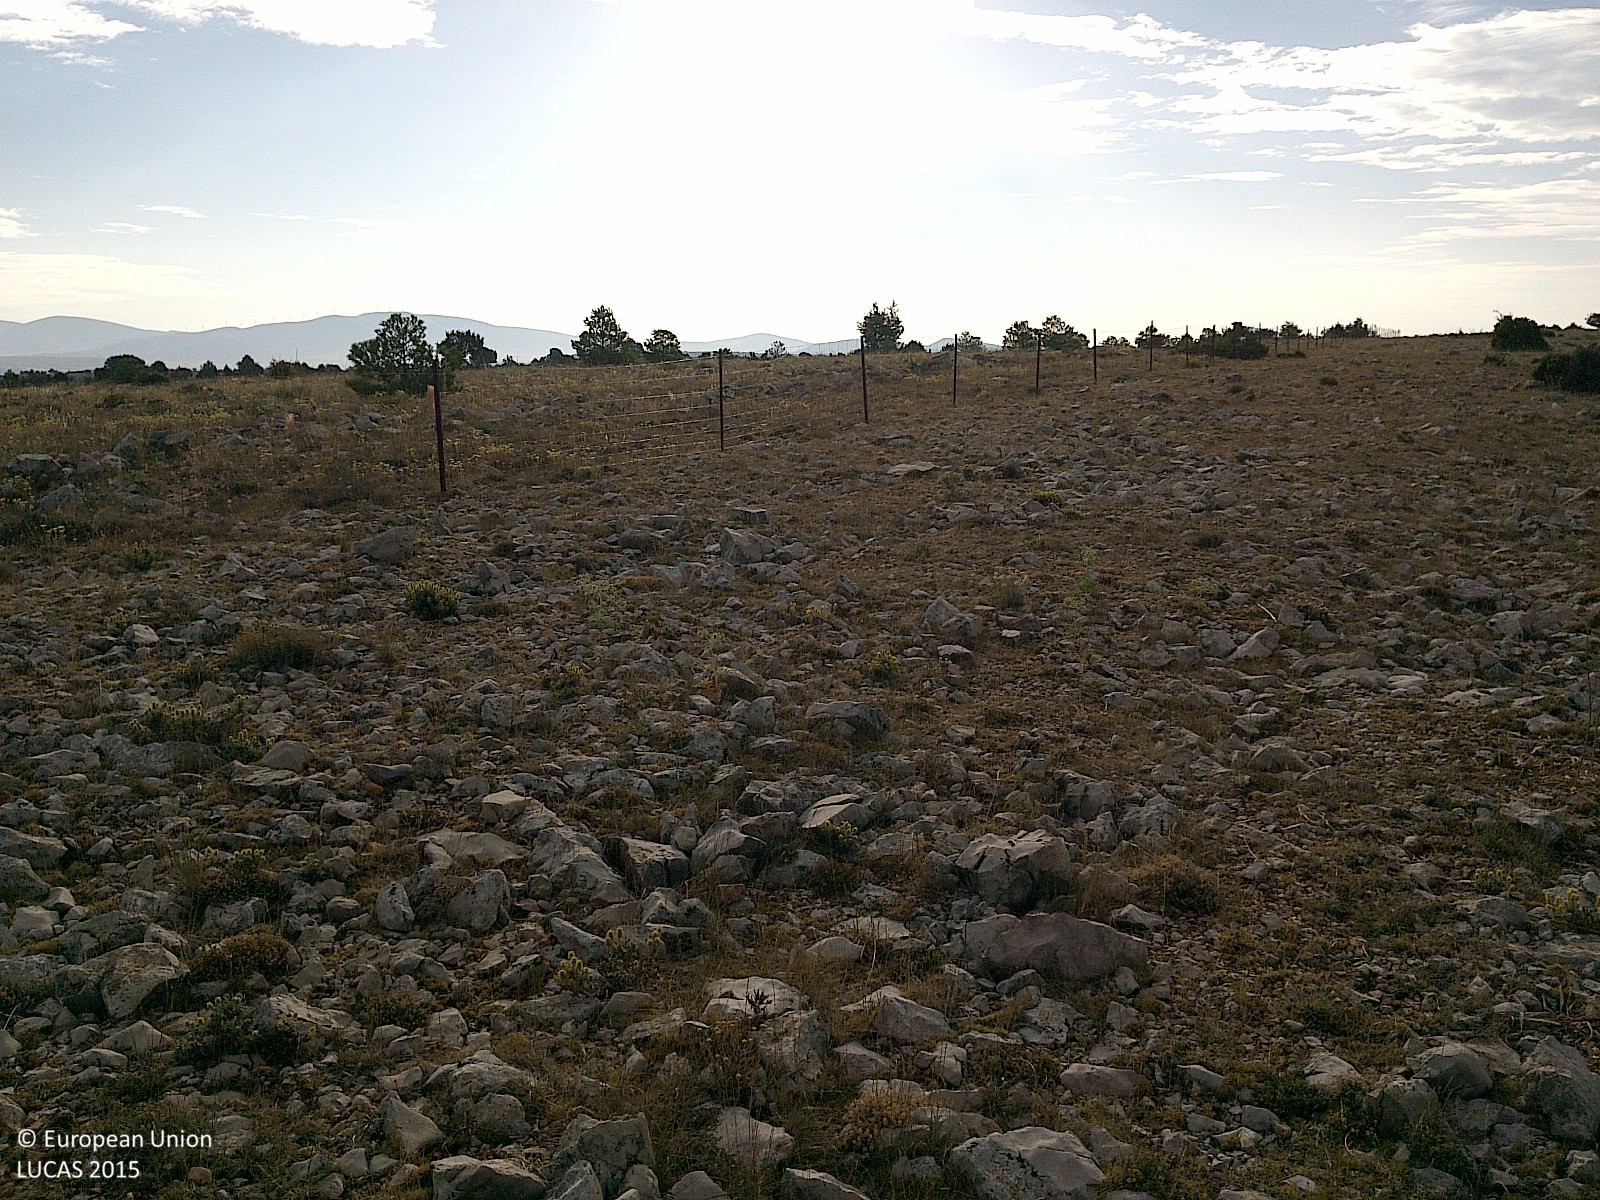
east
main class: Grassland
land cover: Grassland without tree/shrub cover
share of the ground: 25 - 50 %
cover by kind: unconsolidated bare surface 65 %, herbaceous plants 30 %, lichens and mosses 5 %
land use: Agriculture (excluding fallow land and kitchen gardens)
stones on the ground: > 50 %
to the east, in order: Grassland without tree/shrub cover; Fences; Grassland without tree/shrub cover; Grassland with sparse tree/shrub cover; Grassland without tree/shrub cover
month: July
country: ES
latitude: 41.6279
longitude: -1.9986
